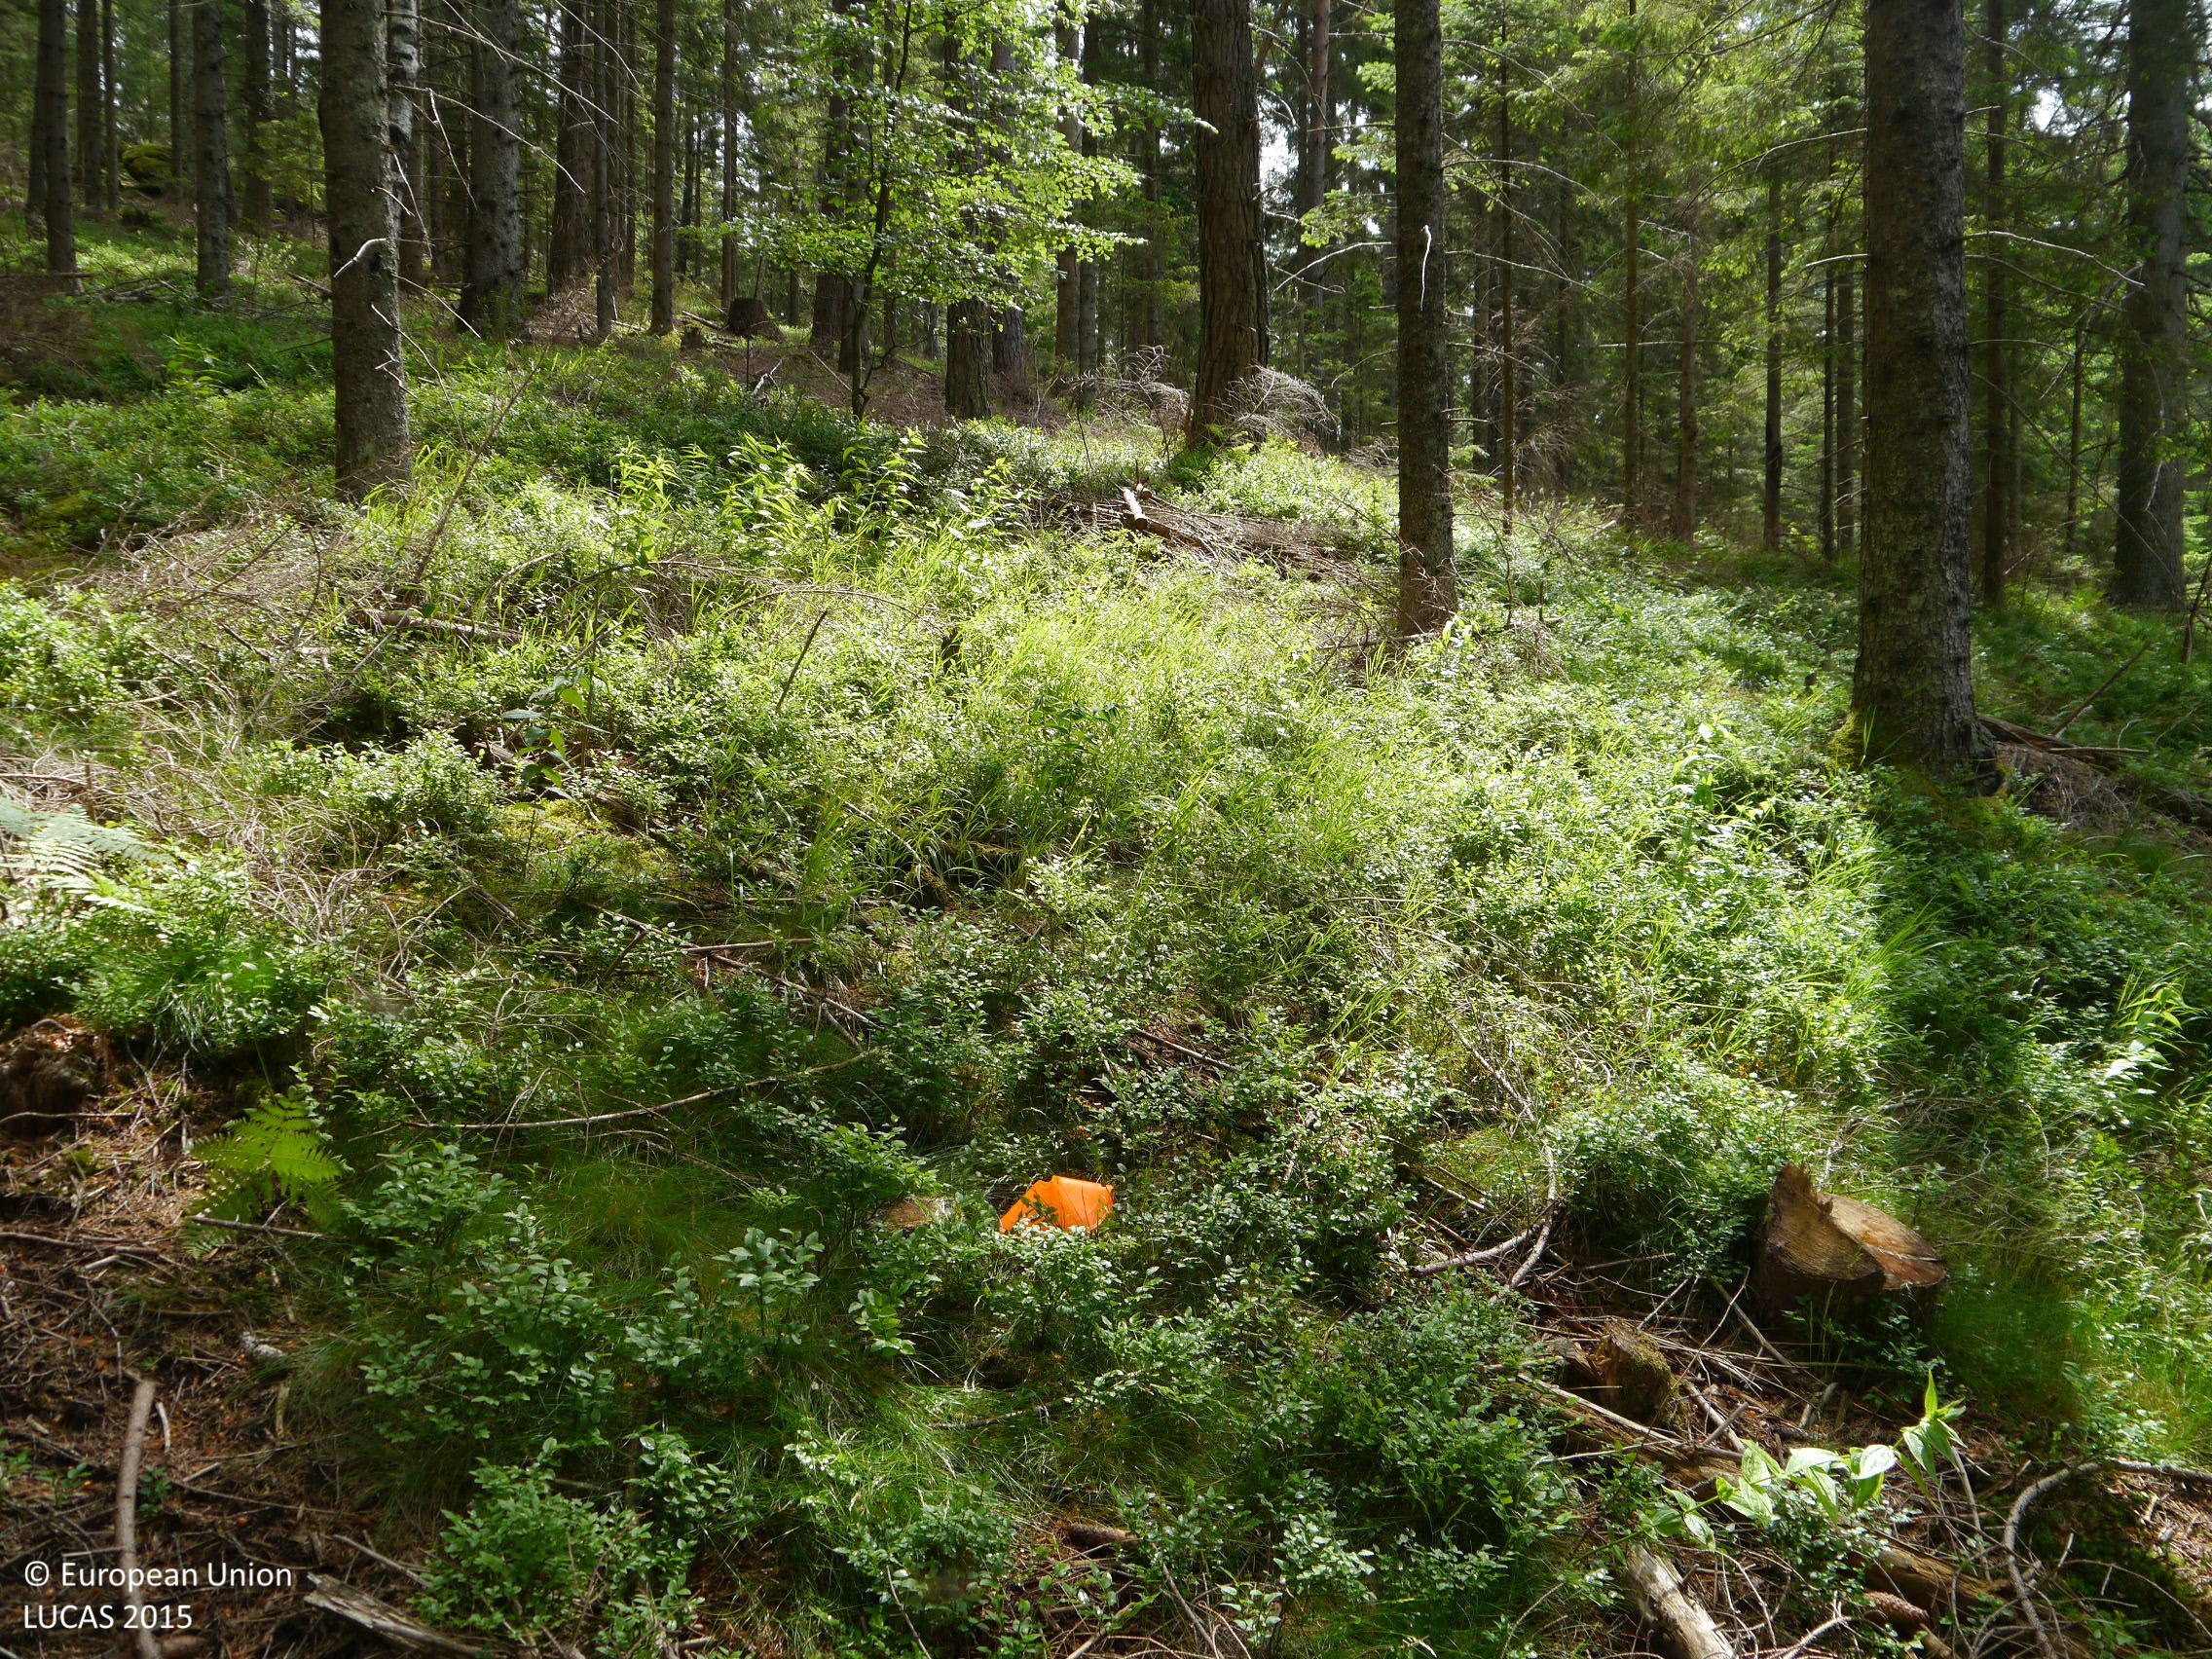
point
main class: Woodland
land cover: Spruce dominated coniferous woodland
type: alpine coniferous forest
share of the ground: > 75 %
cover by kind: coniferous forest trees 70 %, shrubs 20 %, herbaceous plants 10 %
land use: Forestry
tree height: > 5 m
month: June
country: AT
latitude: 46.7353
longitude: 15.0893
